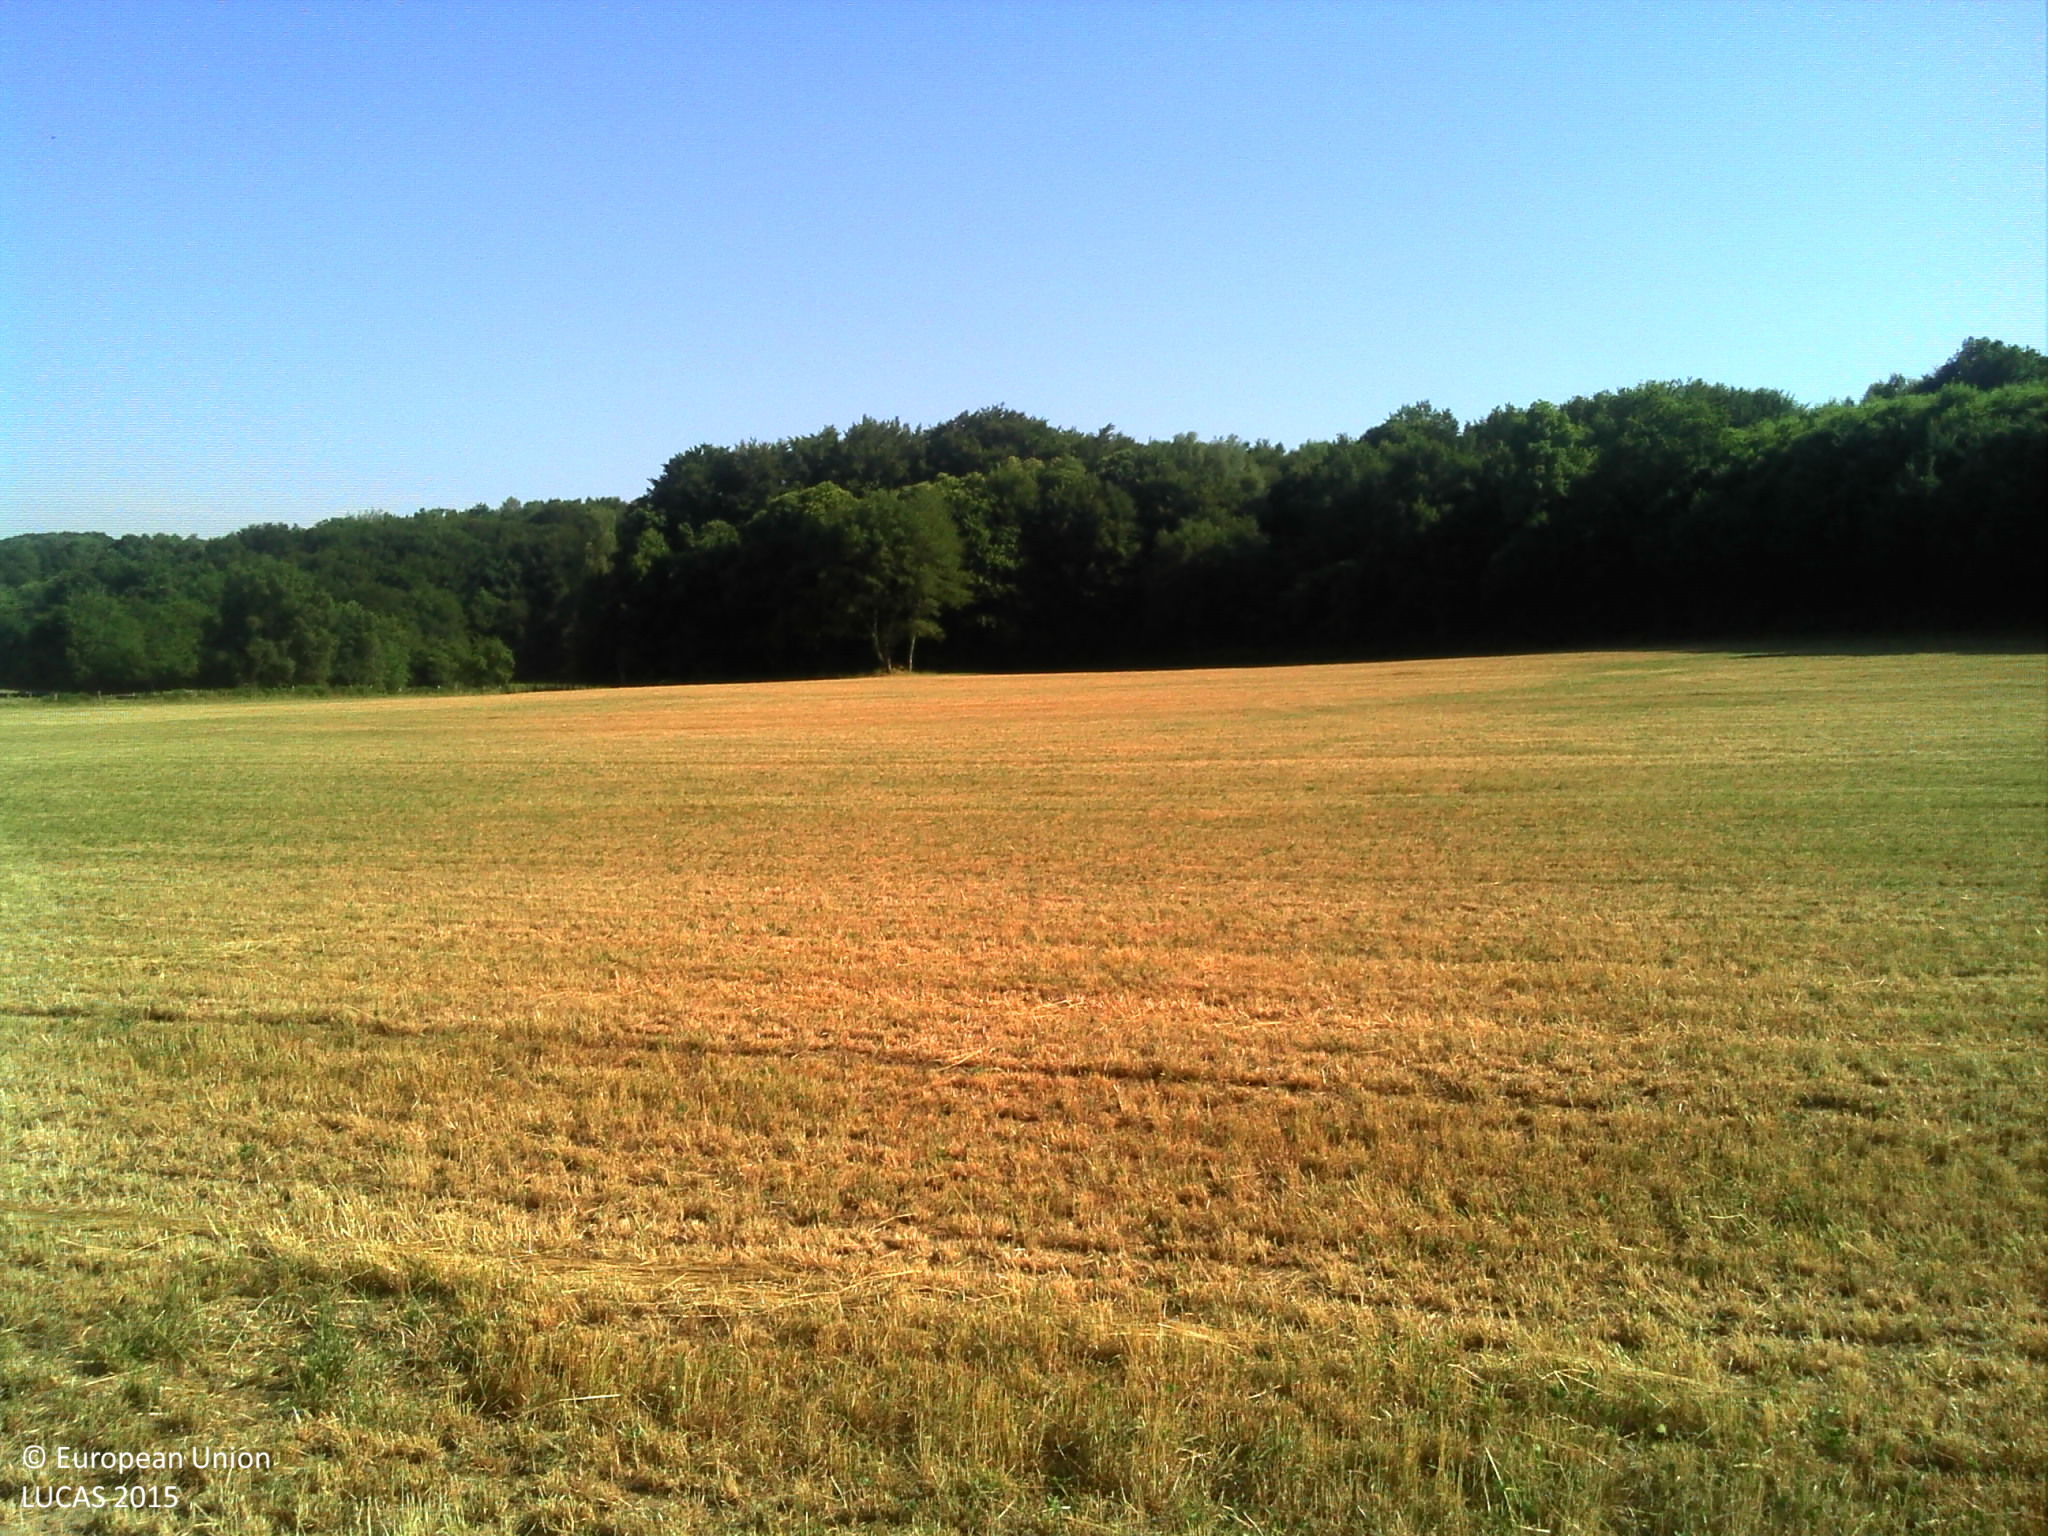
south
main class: Grassland
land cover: Grassland without tree/shrub cover
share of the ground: > 75 %
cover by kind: herbaceous plants 100 %
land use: Agriculture (excluding fallow land and kitchen gardens)
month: July
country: FR
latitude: 46.1226
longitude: 1.7491
